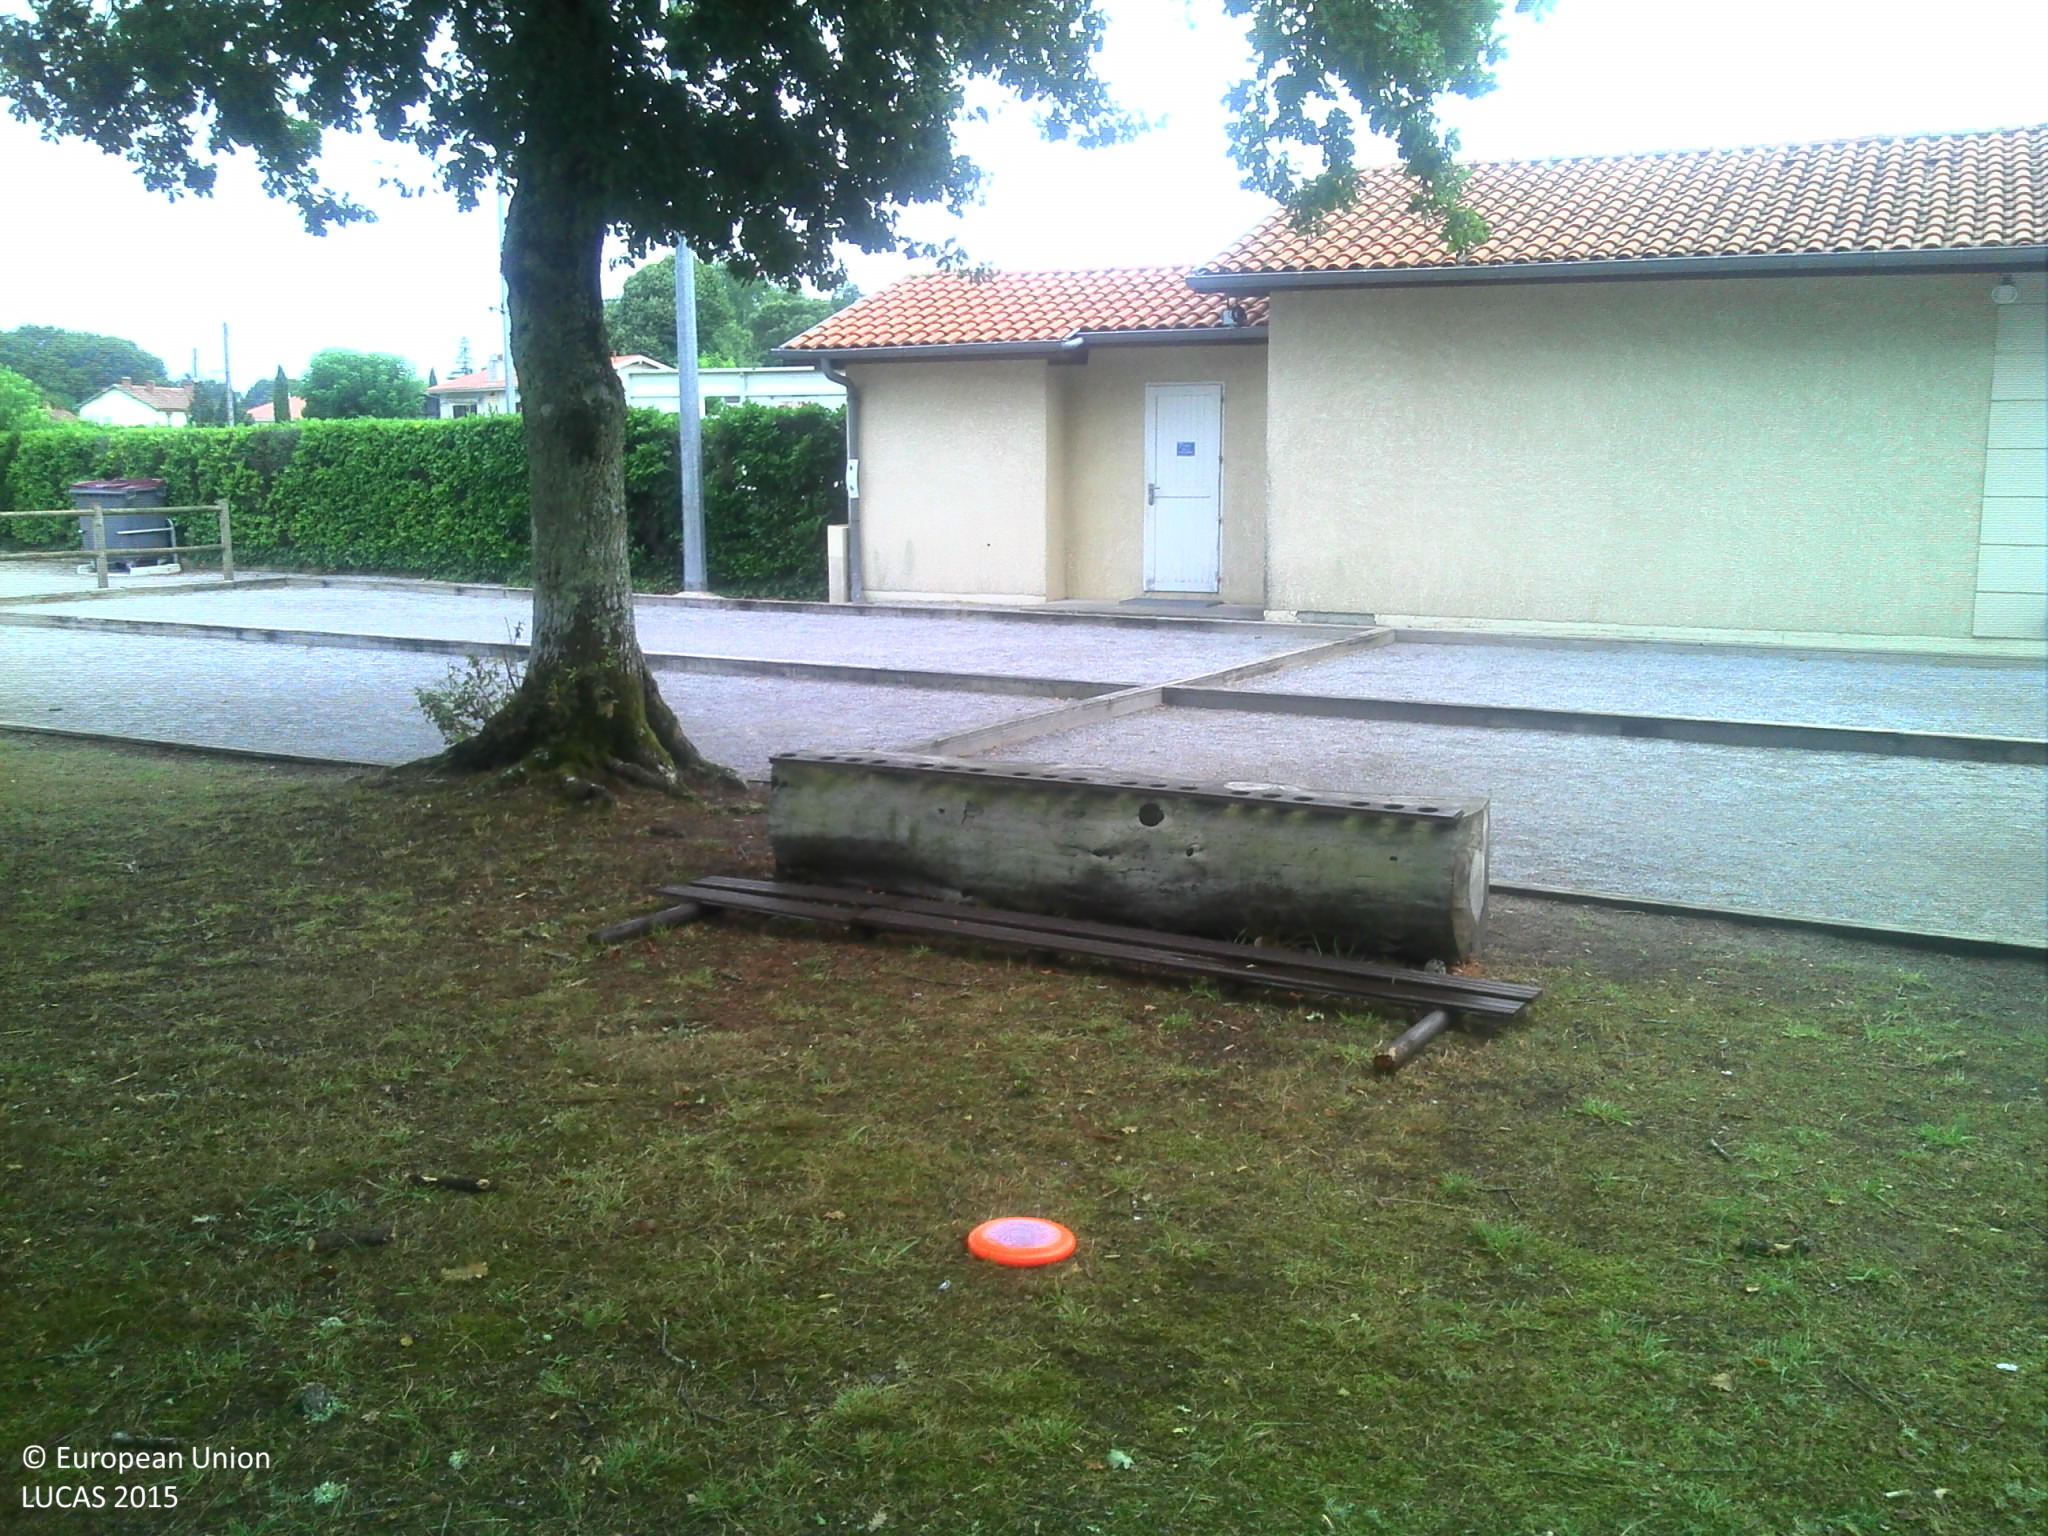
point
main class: Grassland
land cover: Grassland with sparse tree/shrub cover
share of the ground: > 75 %
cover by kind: herbaceous plants 85 %, lichens and mosses 10 %, broadleaved forest trees 5 %
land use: Sport
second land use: Amenities, museums, leisure
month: July
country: FR
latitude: 43.8032
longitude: -1.1419
